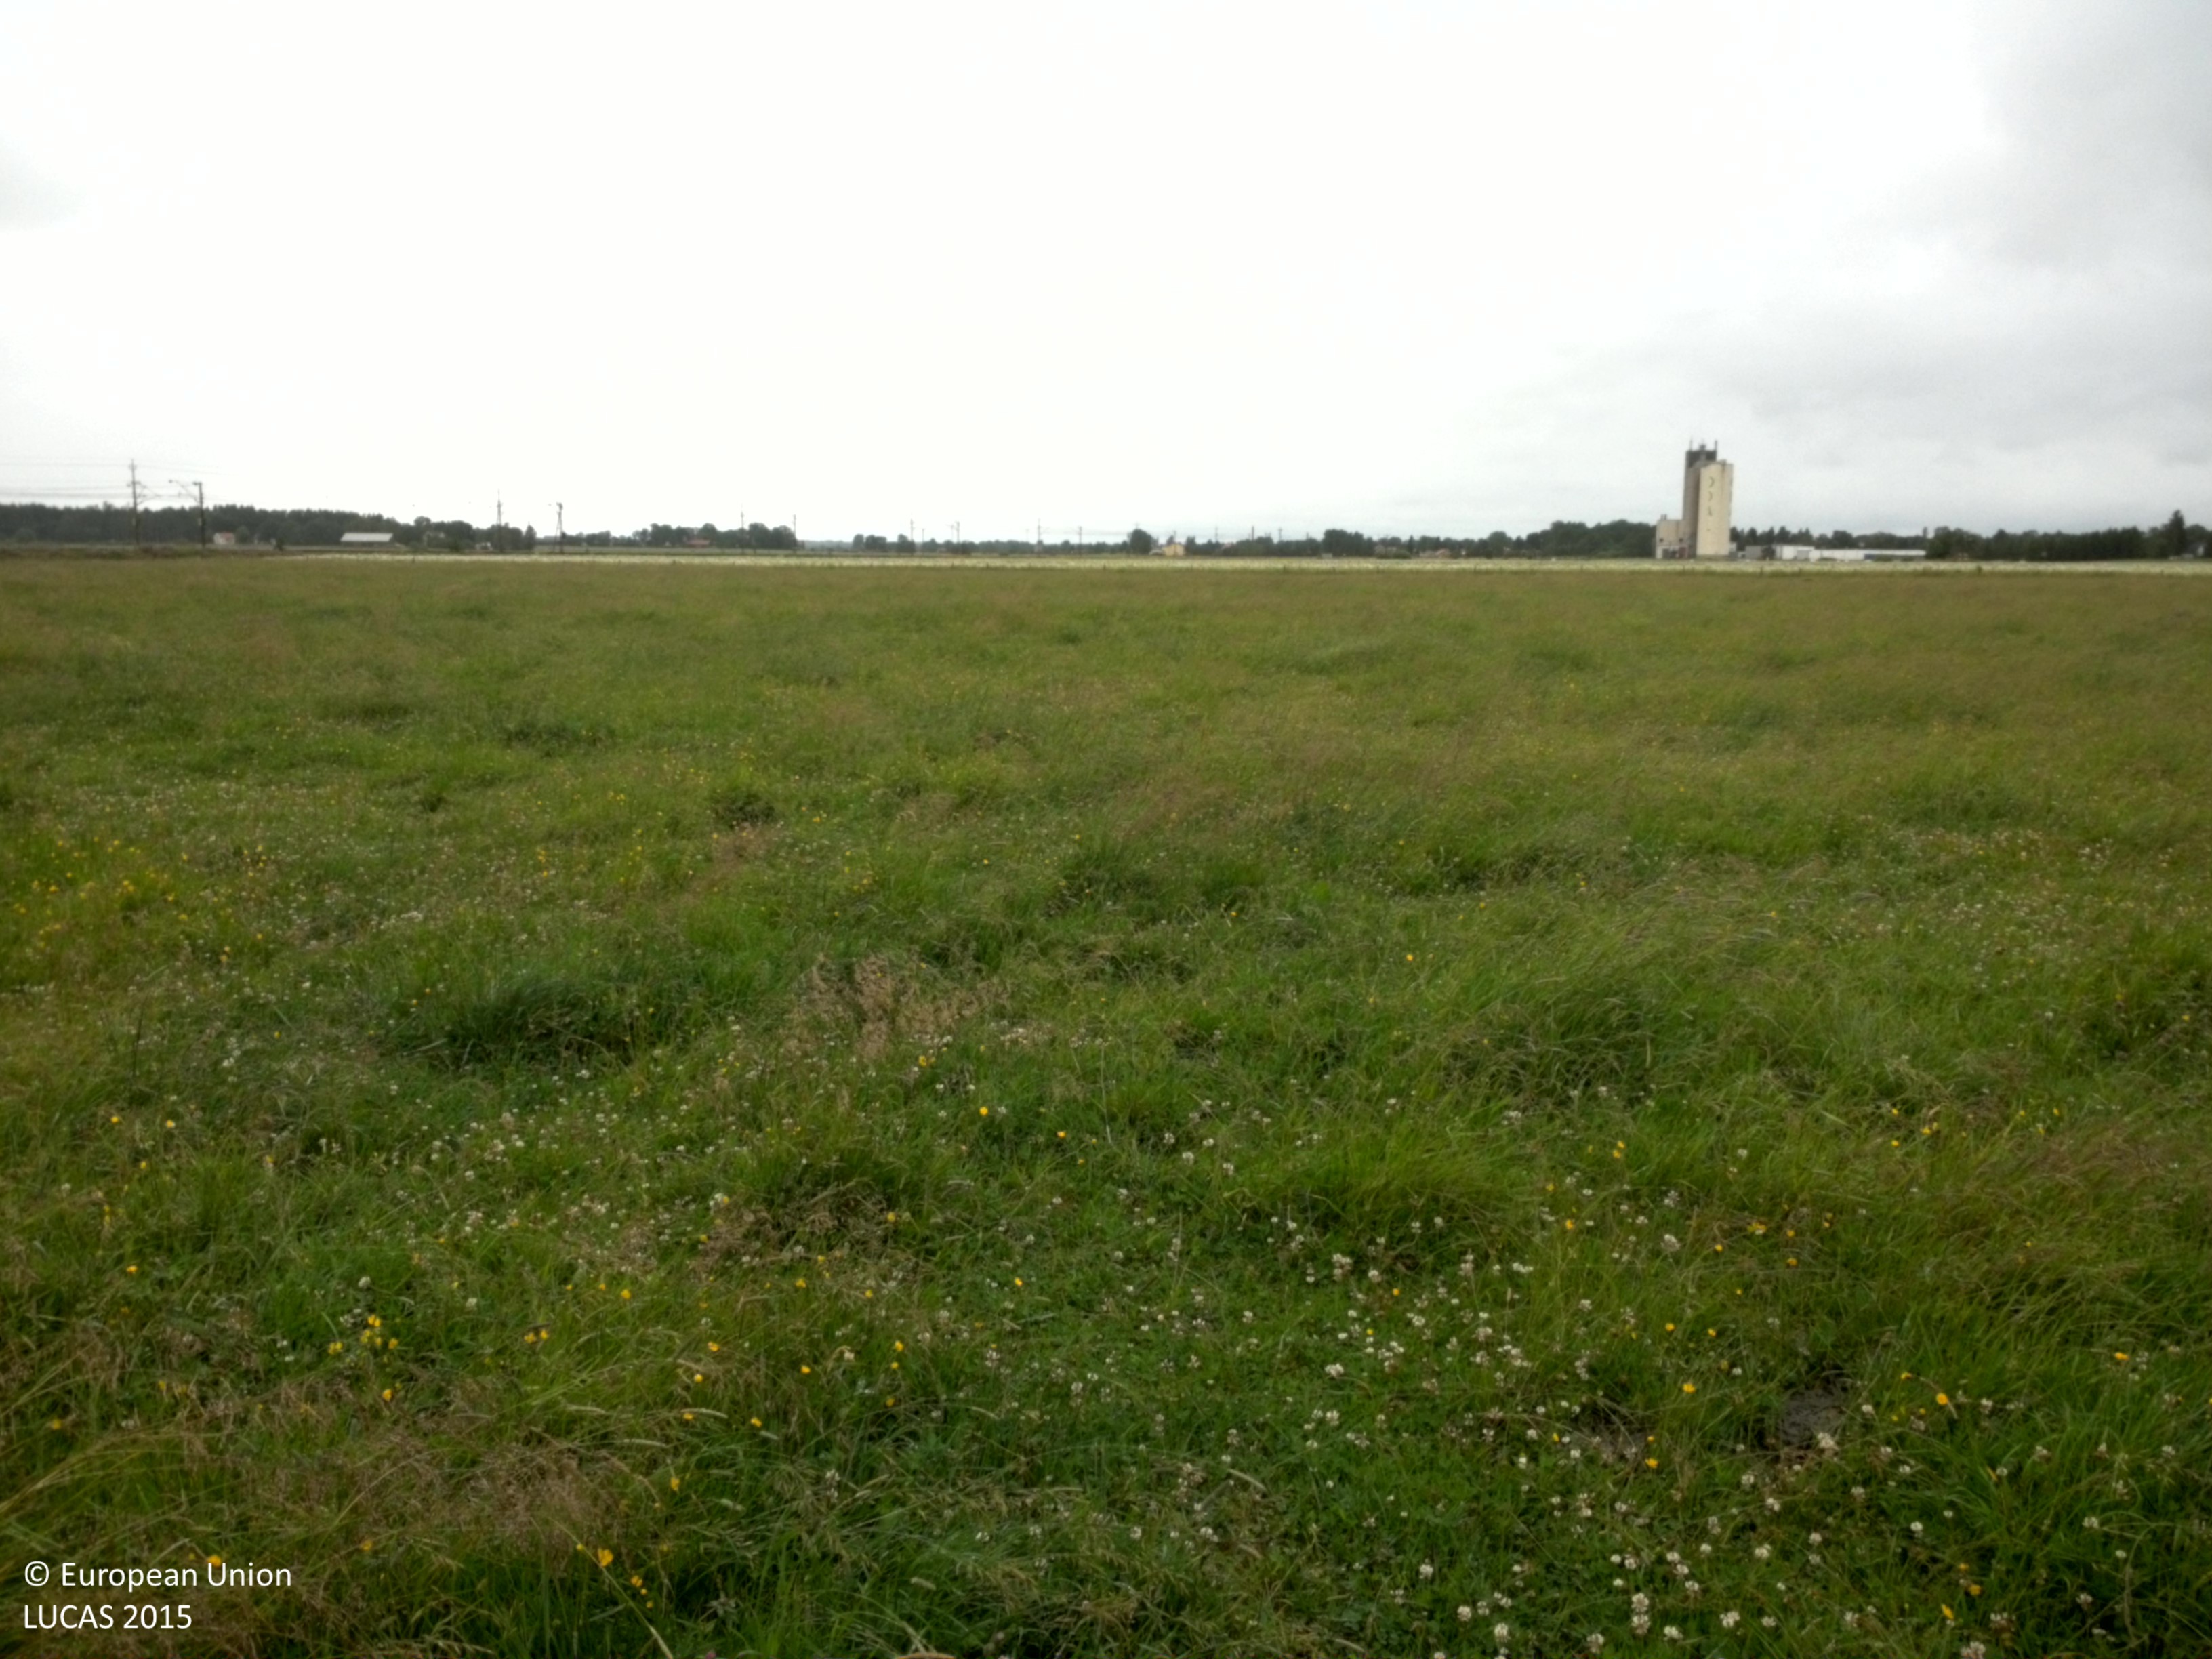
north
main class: Grassland
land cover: Grassland without tree/shrub cover
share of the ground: > 75 %
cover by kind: herbaceous plants 100 %
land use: Agriculture (excluding fallow land and kitchen gardens)
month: July
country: SE
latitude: 58.5564
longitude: 13.9980
